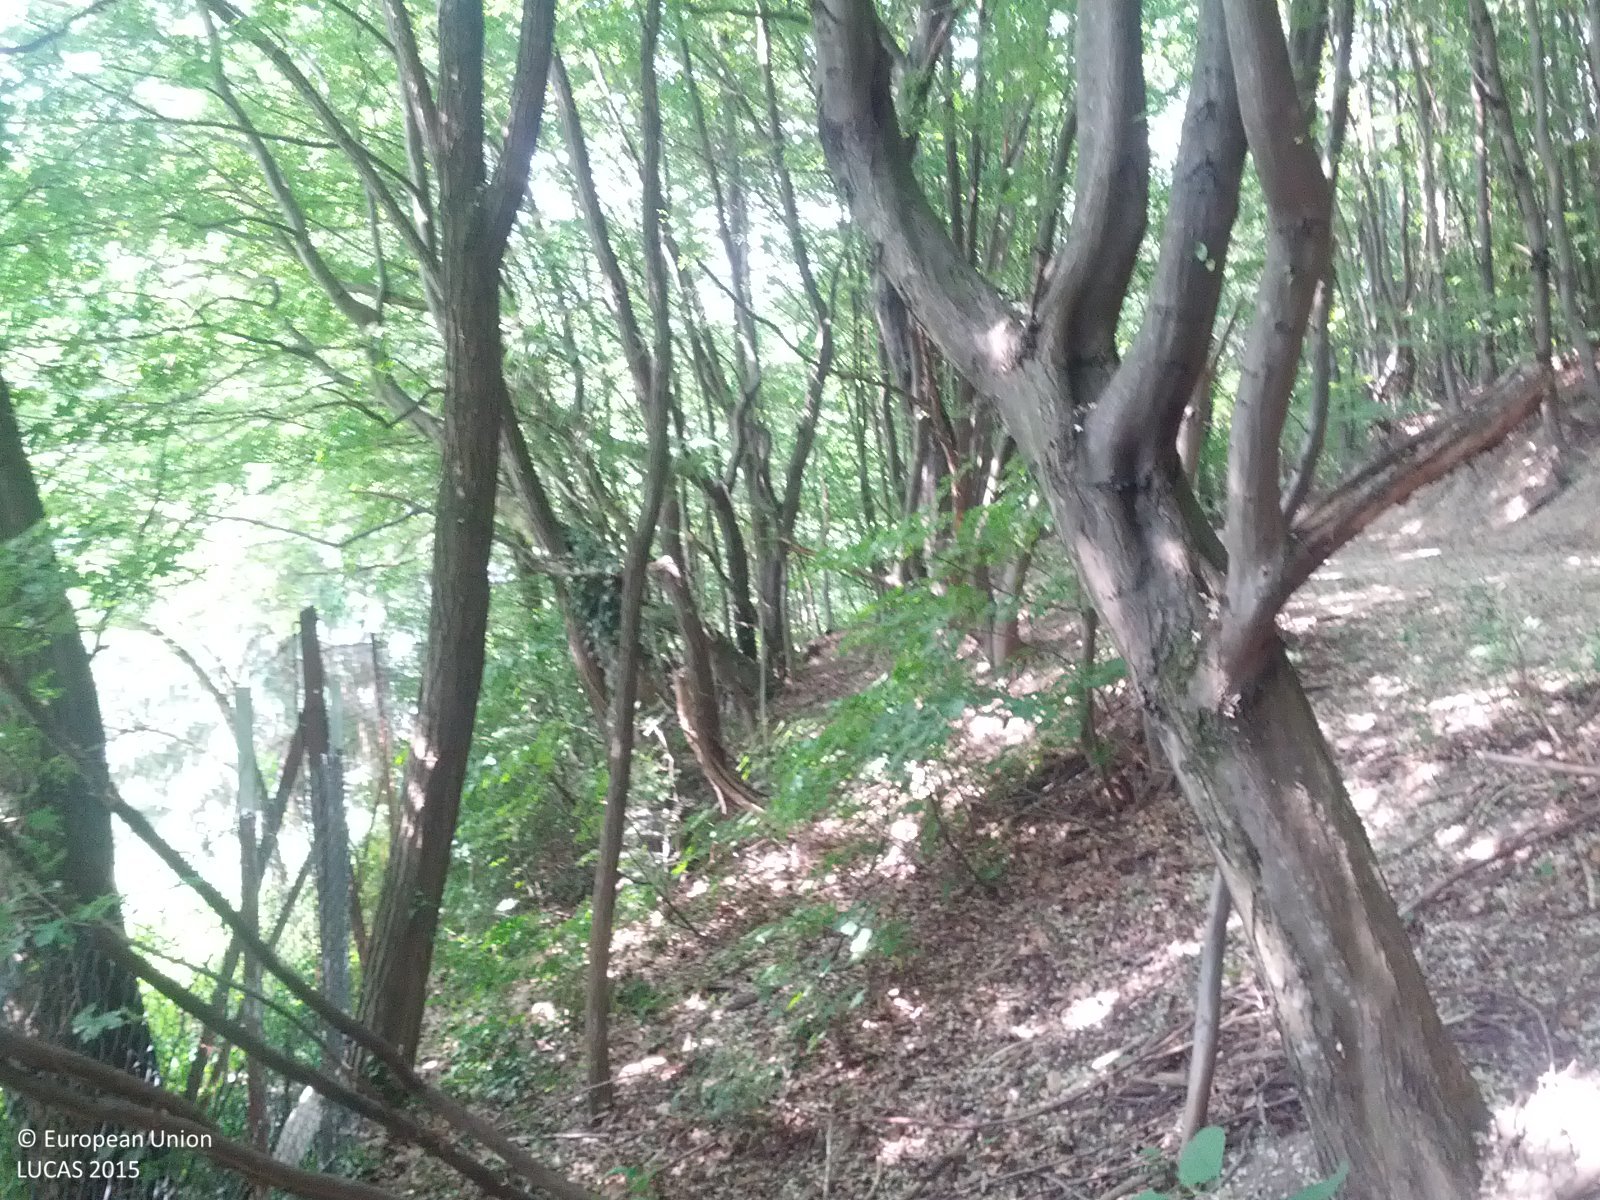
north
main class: Woodland
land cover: Broadleaved woodland
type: beech forest
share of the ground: > 75 %
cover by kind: broadleaved forest trees 100 %
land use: Forestry
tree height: > 5 m
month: June
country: AT
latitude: 48.1617
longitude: 16.1213
